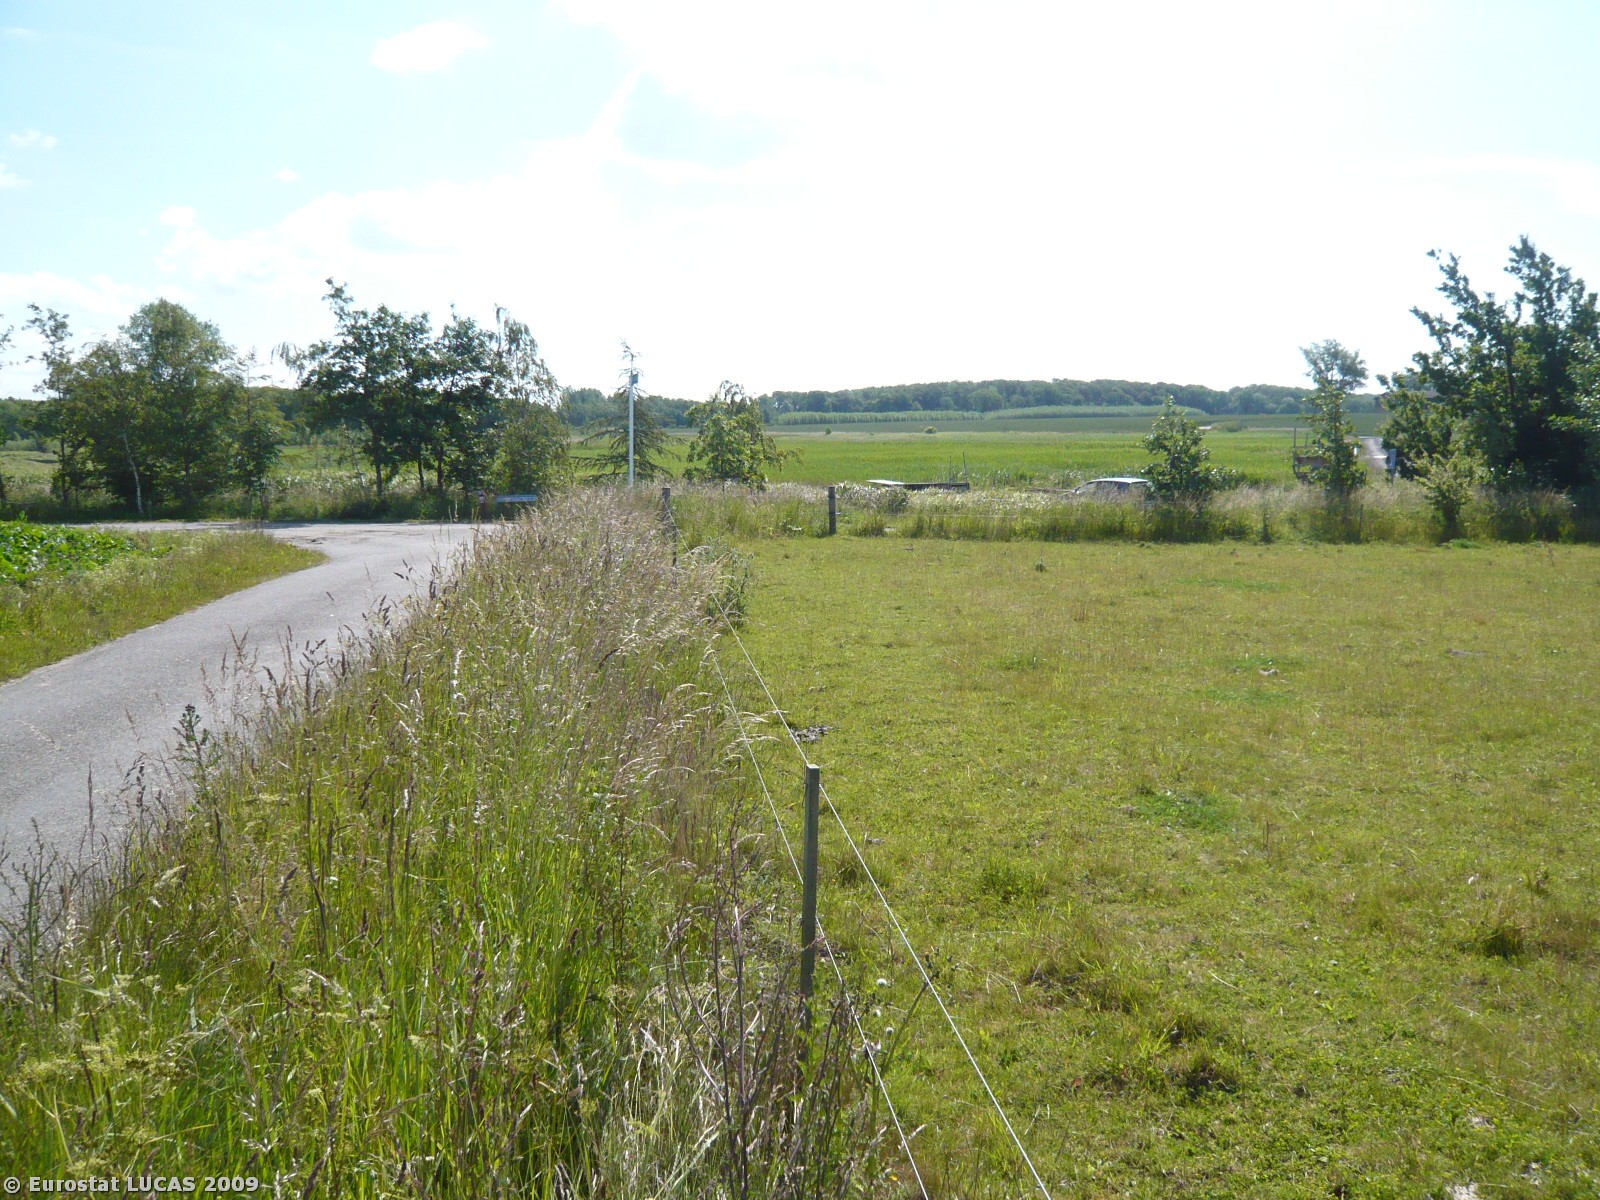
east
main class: Grassland
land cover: Grassland without tree/shrub cover
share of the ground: > 75 %
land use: Agriculture (excluding fallow land and kitchen gardens)
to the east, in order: Grassland without tree/shrub cover; Fences; Grassland without tree/shrub cover; Paved roads, cycling and walking lanes; Grassland without tree/shrub cover; Permanent industrial crops; Grass margins; Tracks; Bare land; Permanent industrial crops; Inland running water; Permanent industrial crops
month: June
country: DK
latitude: 54.6677
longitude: 11.5960
